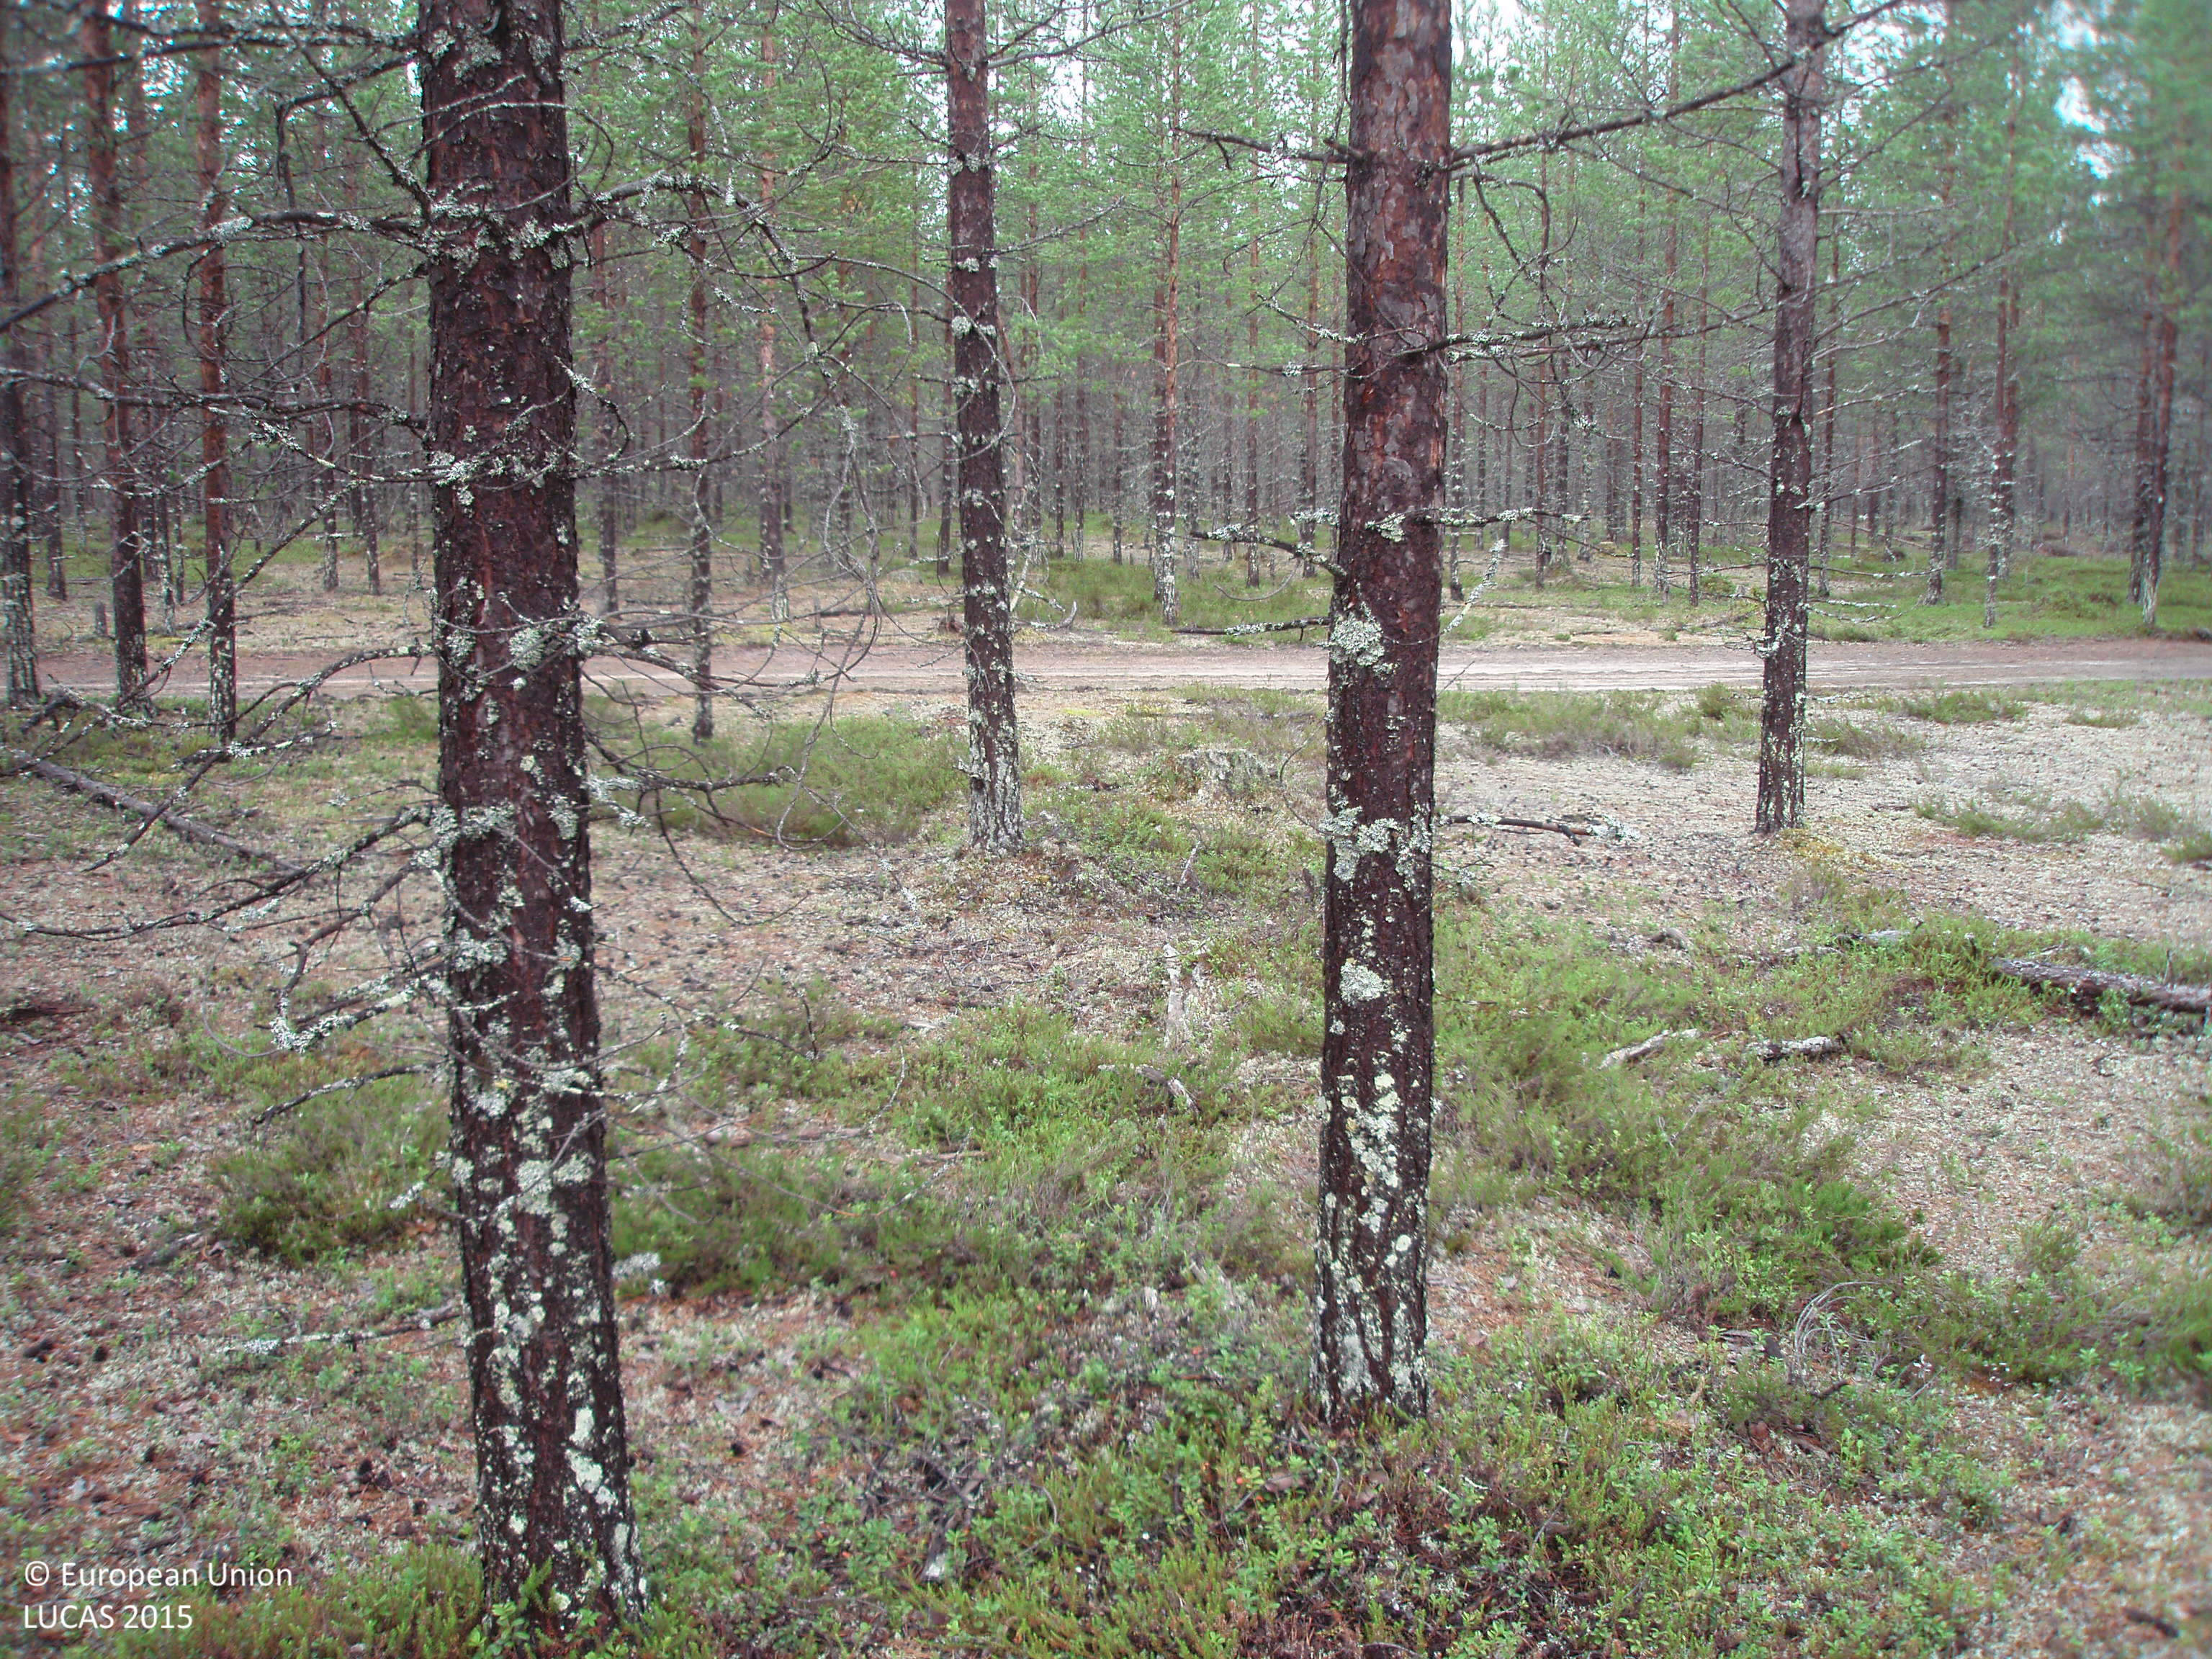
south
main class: Woodland
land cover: Pine dominated coniferous woodland
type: boreal forest
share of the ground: > 75 %
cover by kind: coniferous forest trees 75 %, shrubs 20 %, lichens and mosses 5 %
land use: Forestry
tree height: > 5 m
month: July
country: FI
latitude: 65.9992
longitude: 28.0515
